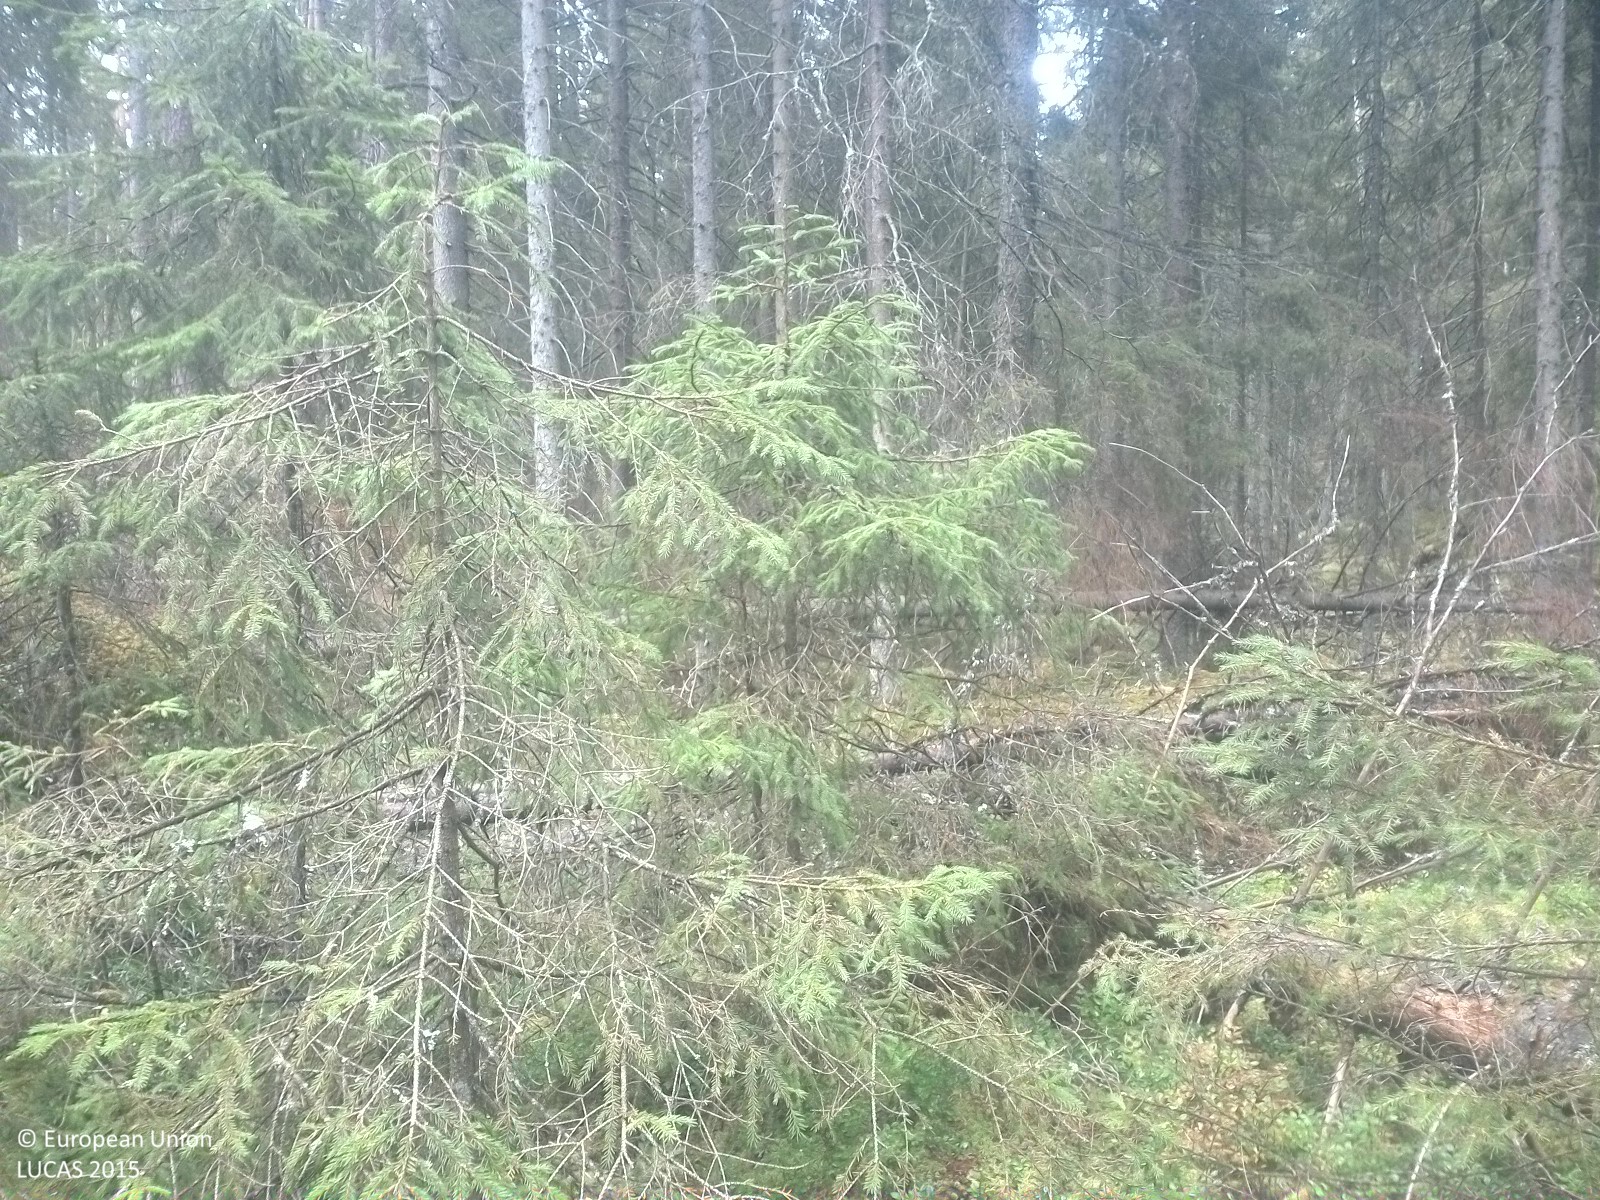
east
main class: Woodland
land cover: Spruce dominated coniferous woodland
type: boreal forest
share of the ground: 25 - 50 %
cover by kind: coniferous forest trees 40 %, herbaceous plants 35 %, lichens and mosses 25 %
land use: Forestry
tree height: > 5 m
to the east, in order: Spruce dominated coniferous woodland; Other coniferous woodland
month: August
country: SE
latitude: 58.9145
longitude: 15.6017
